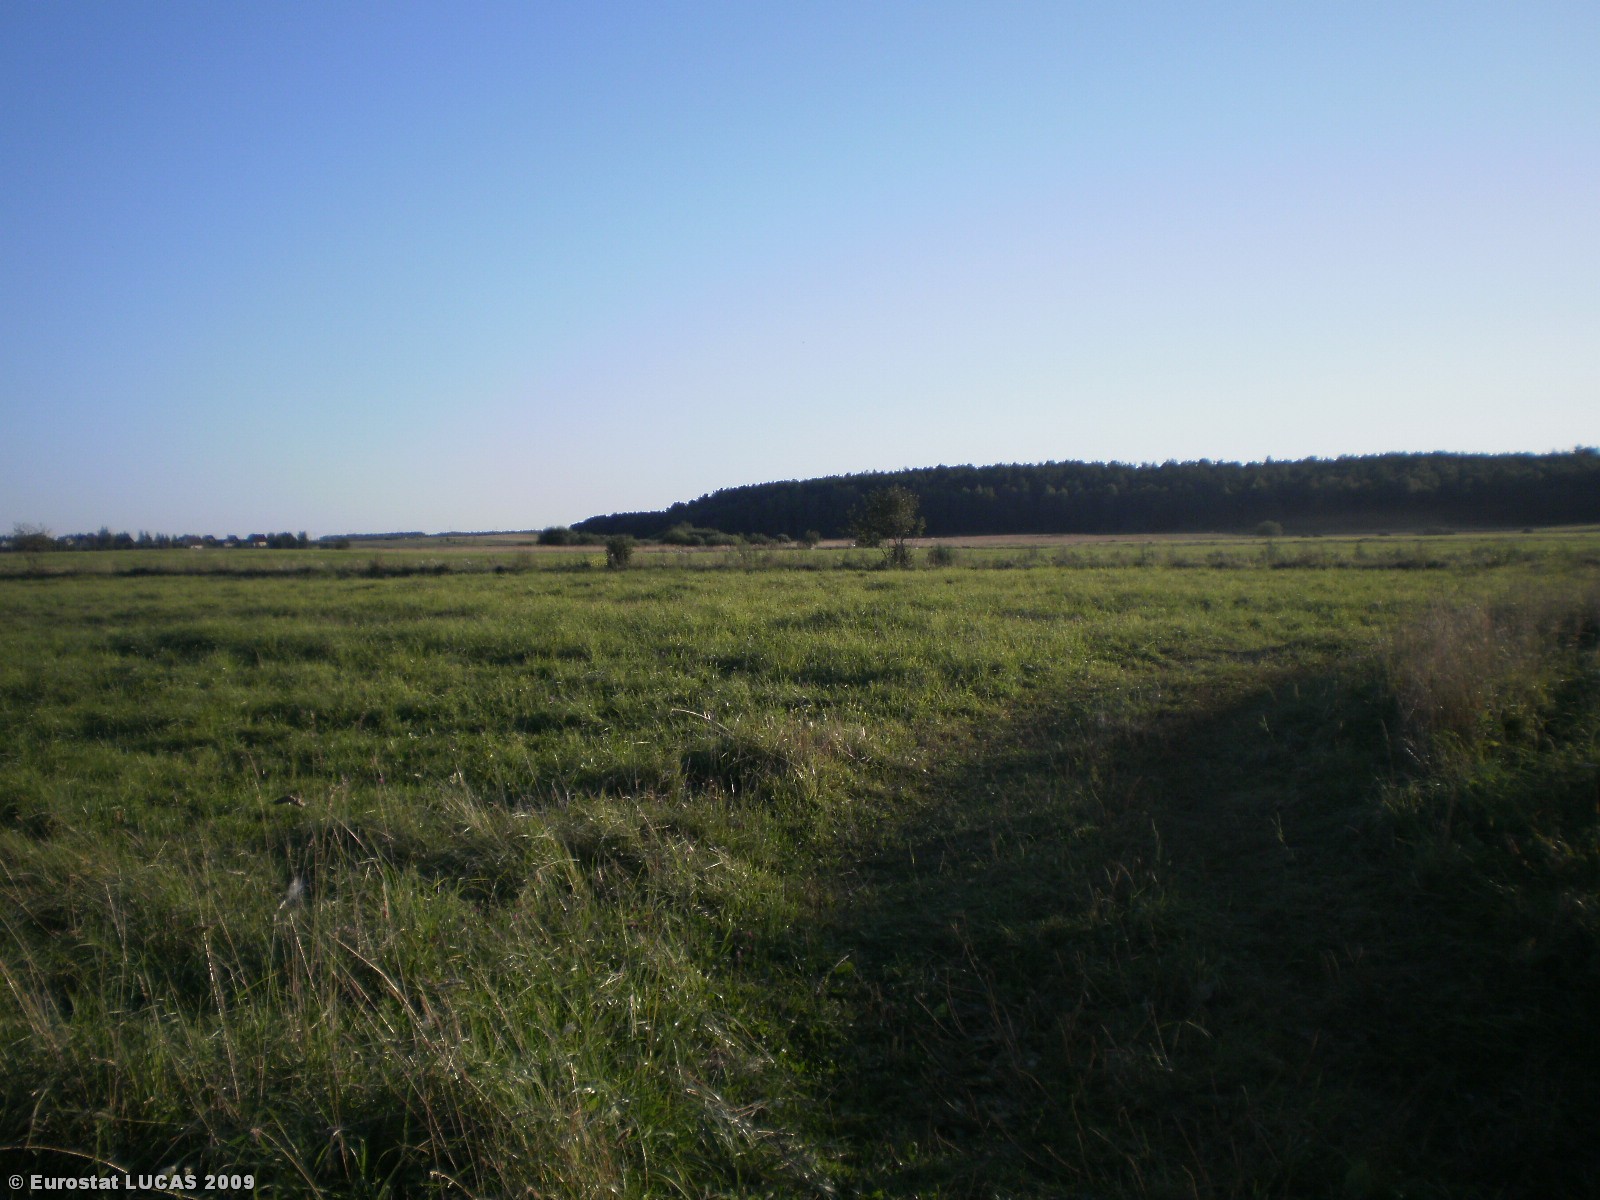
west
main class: Grassland
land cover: Grassland without tree/shrub cover
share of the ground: > 75 %
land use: Agriculture (excluding fallow land and kitchen gardens)
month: August
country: LT
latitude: 54.8726
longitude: 24.5811
